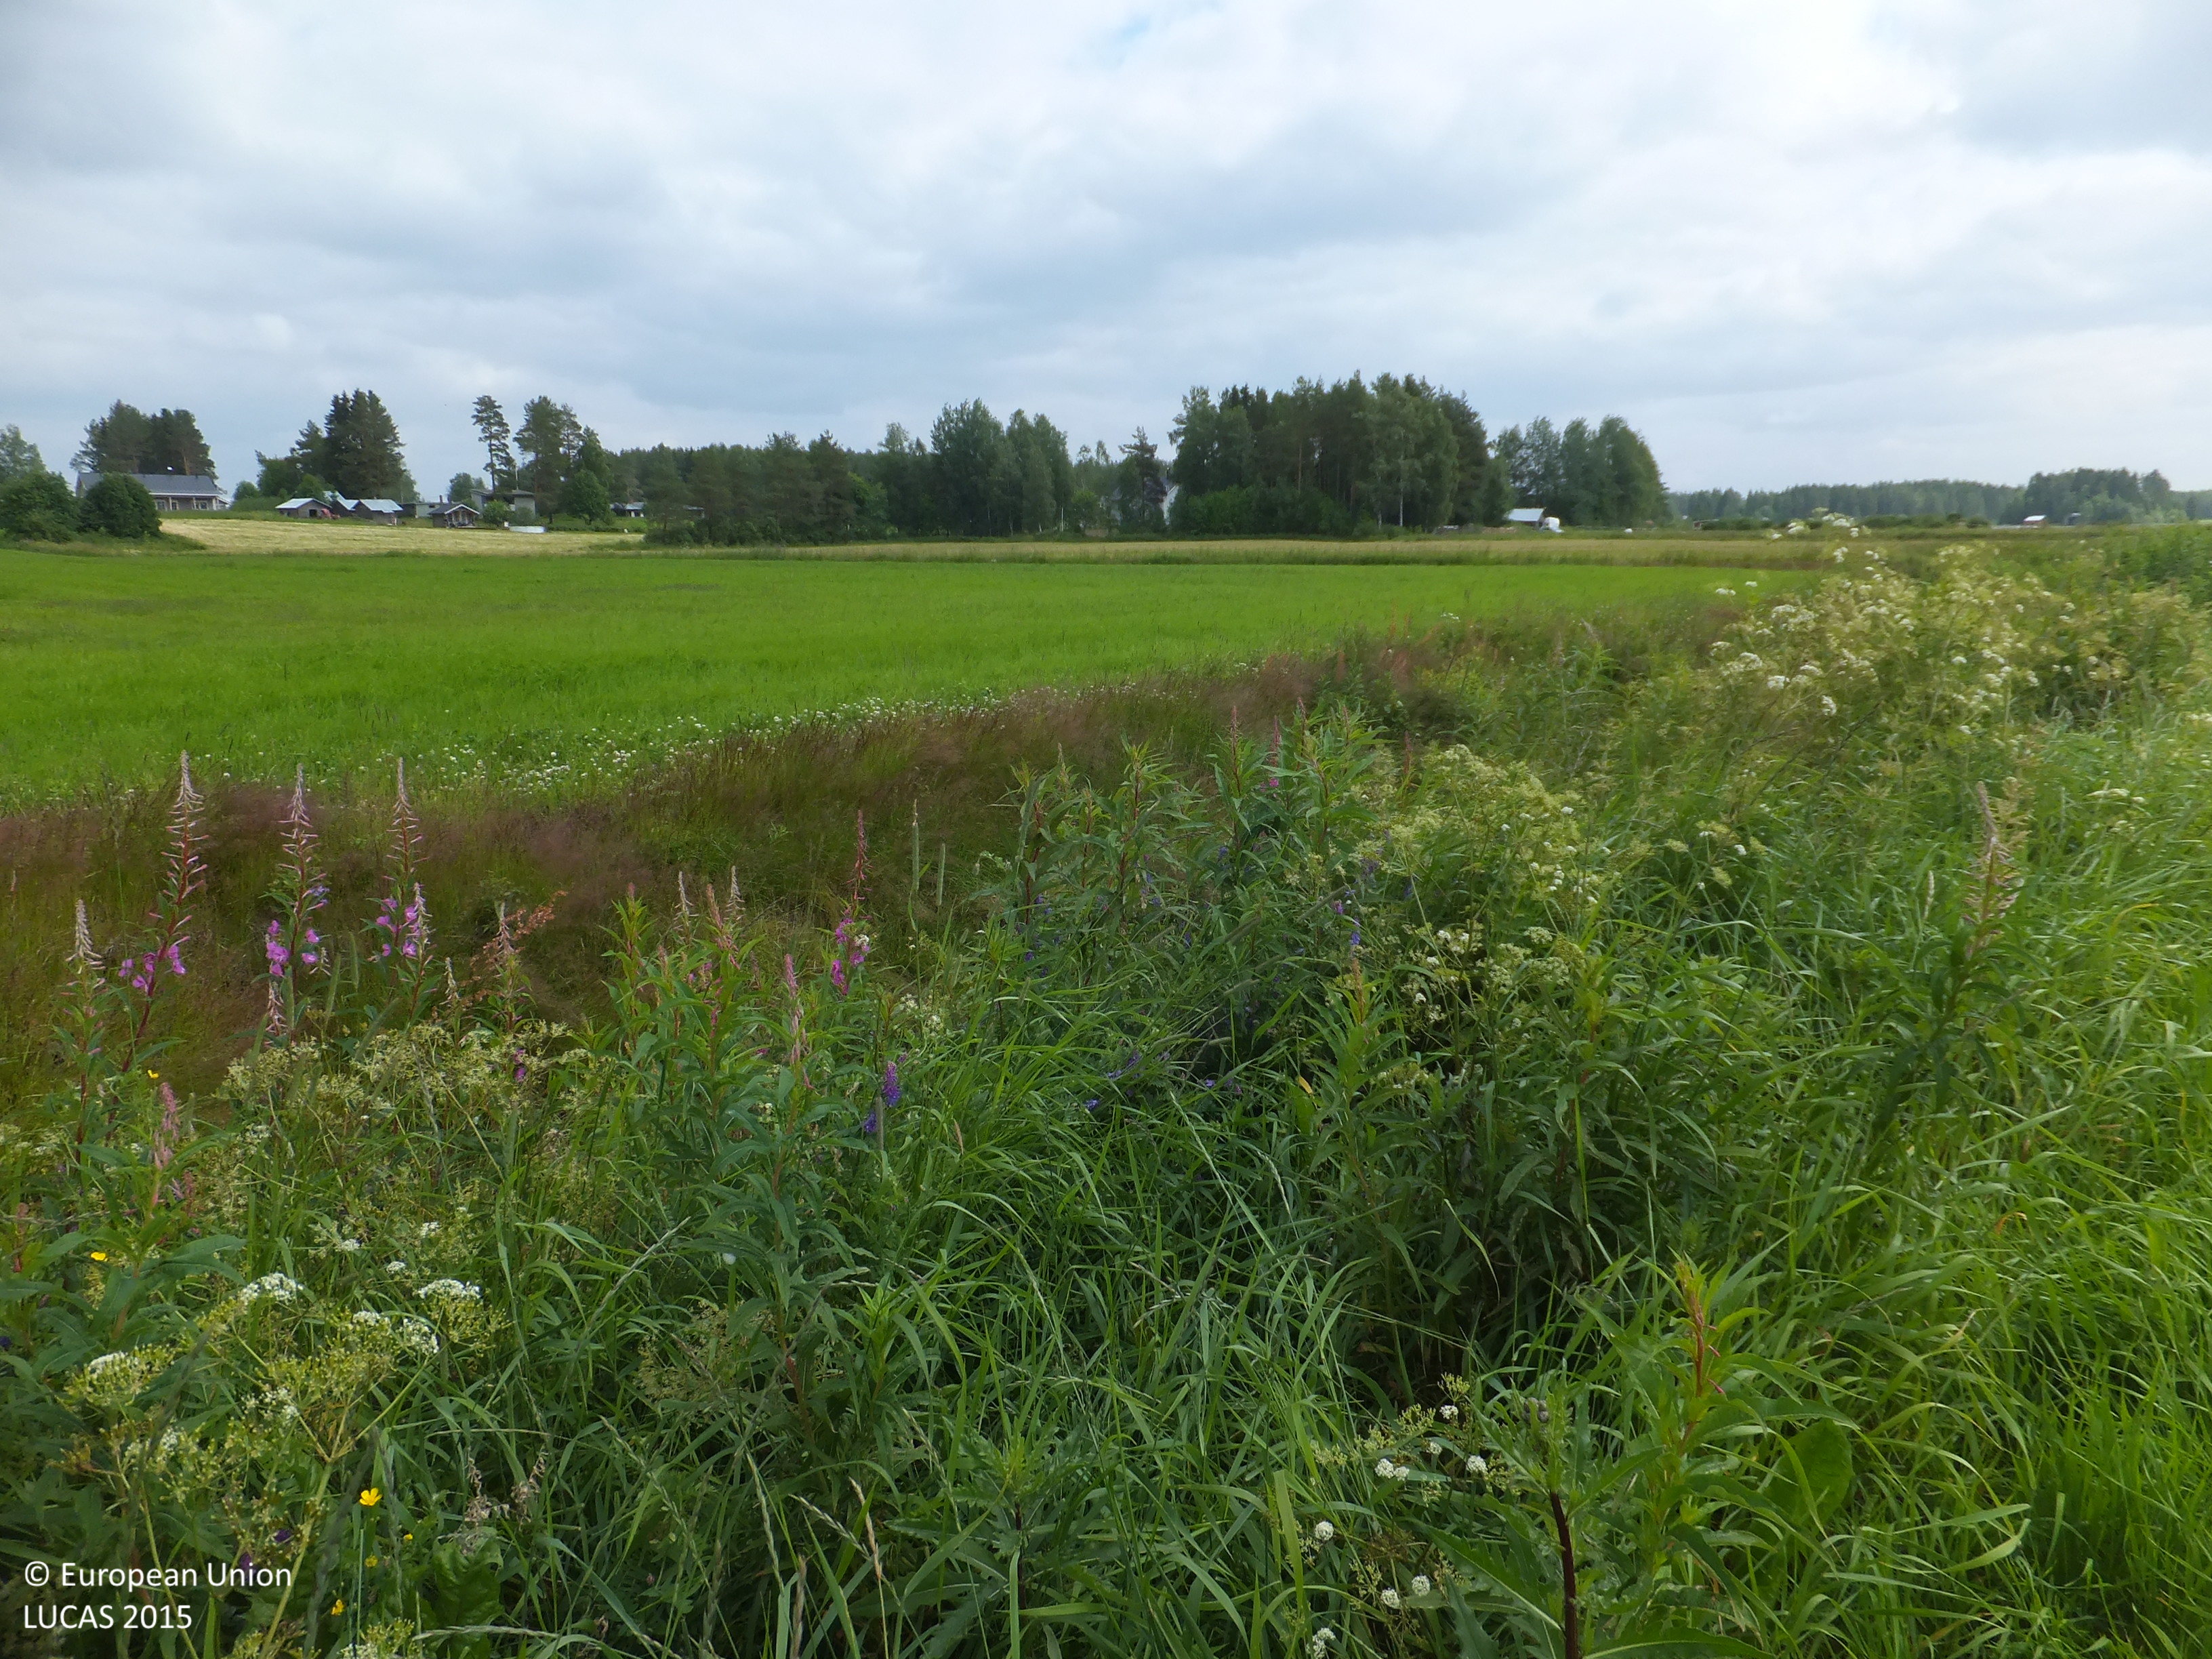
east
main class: Grassland
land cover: Grassland without tree/shrub cover
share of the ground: > 75 %
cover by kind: herbaceous plants 100 %
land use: Agriculture (excluding fallow land and kitchen gardens)
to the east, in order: Grassland without tree/shrub cover; Ditches and canals; Grassland without tree/shrub cover; Temporary grasslands; Grass margins; Ditches and canals; Grass margins; Temporary grasslands; Pine dominated mixed woodland; Artificial constructions in urban areas; Grassland without tree/shrub cover
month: July
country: FI
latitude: 63.4755
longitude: 23.0000
